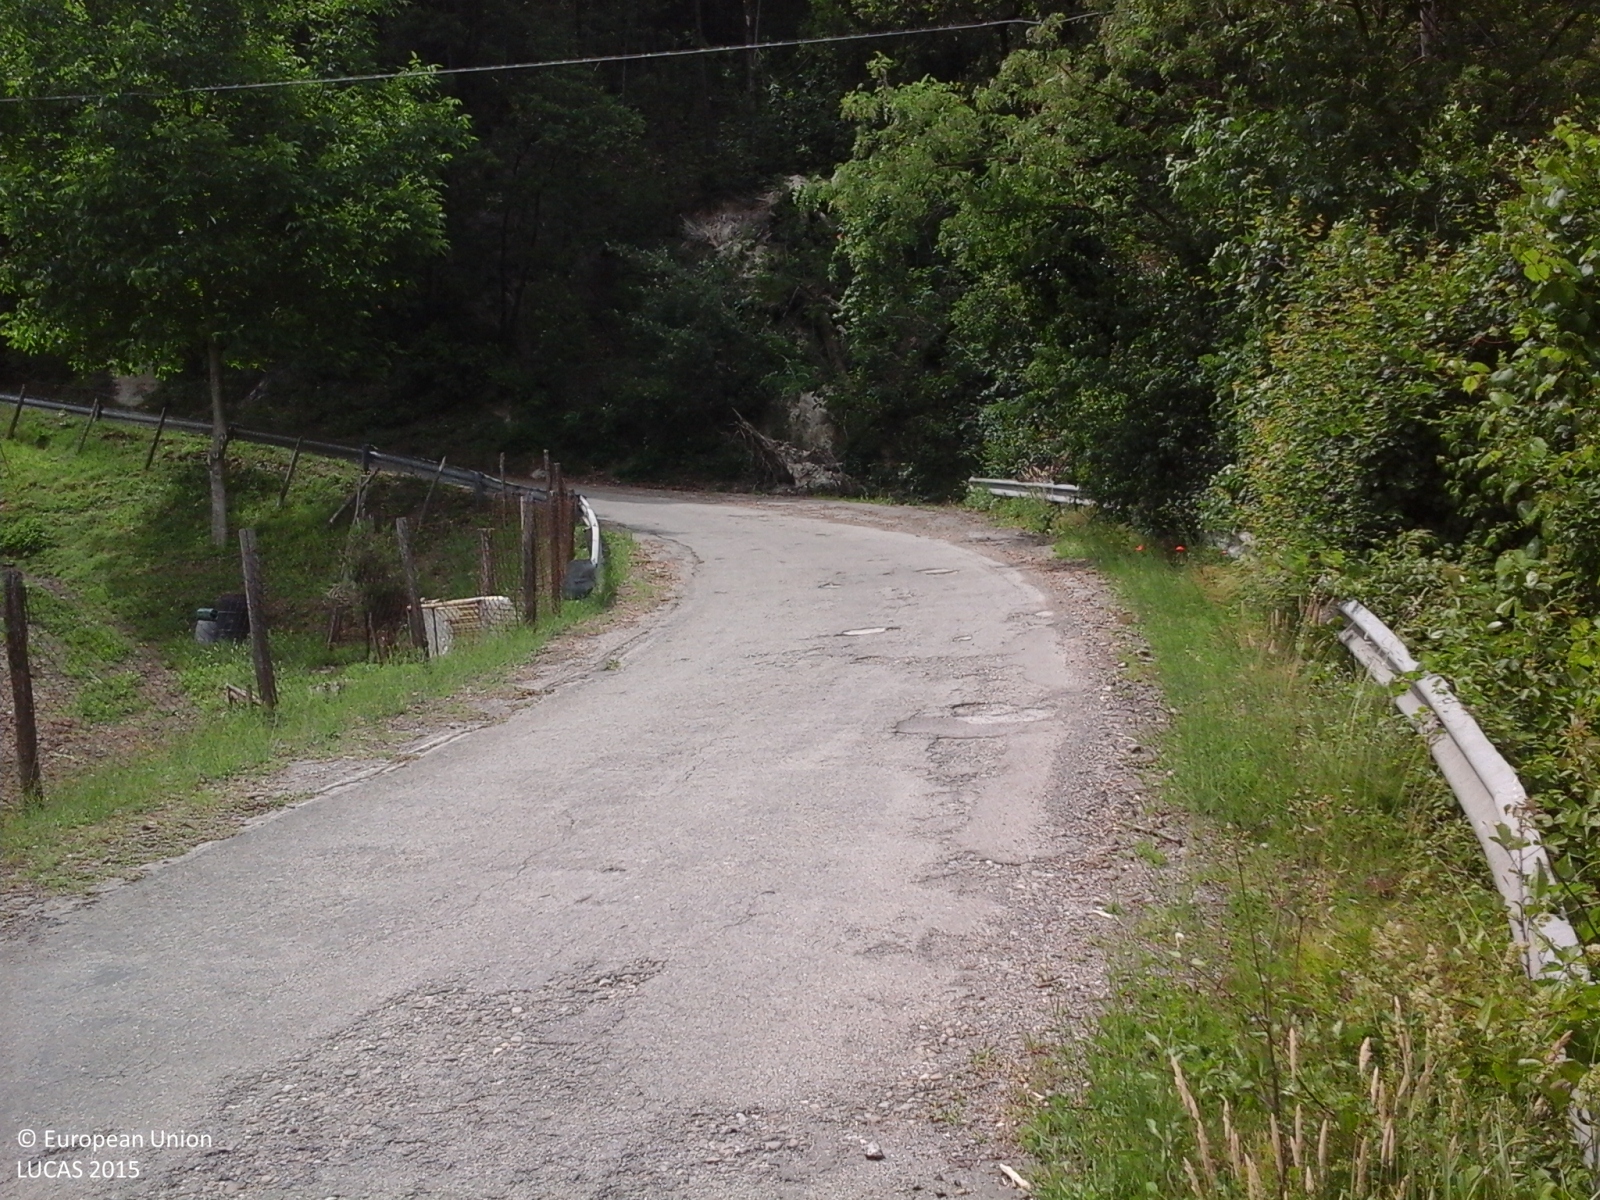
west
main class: Woodland
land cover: Broadleaved woodland
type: thermophilous deciduous forest
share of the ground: > 75 %
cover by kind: broadleaved forest trees 80 %, shrubs 15 %, herbaceous plants 5 %
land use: Forestry
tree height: > 5 m
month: May
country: IT
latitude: 44.2716
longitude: 11.1874
